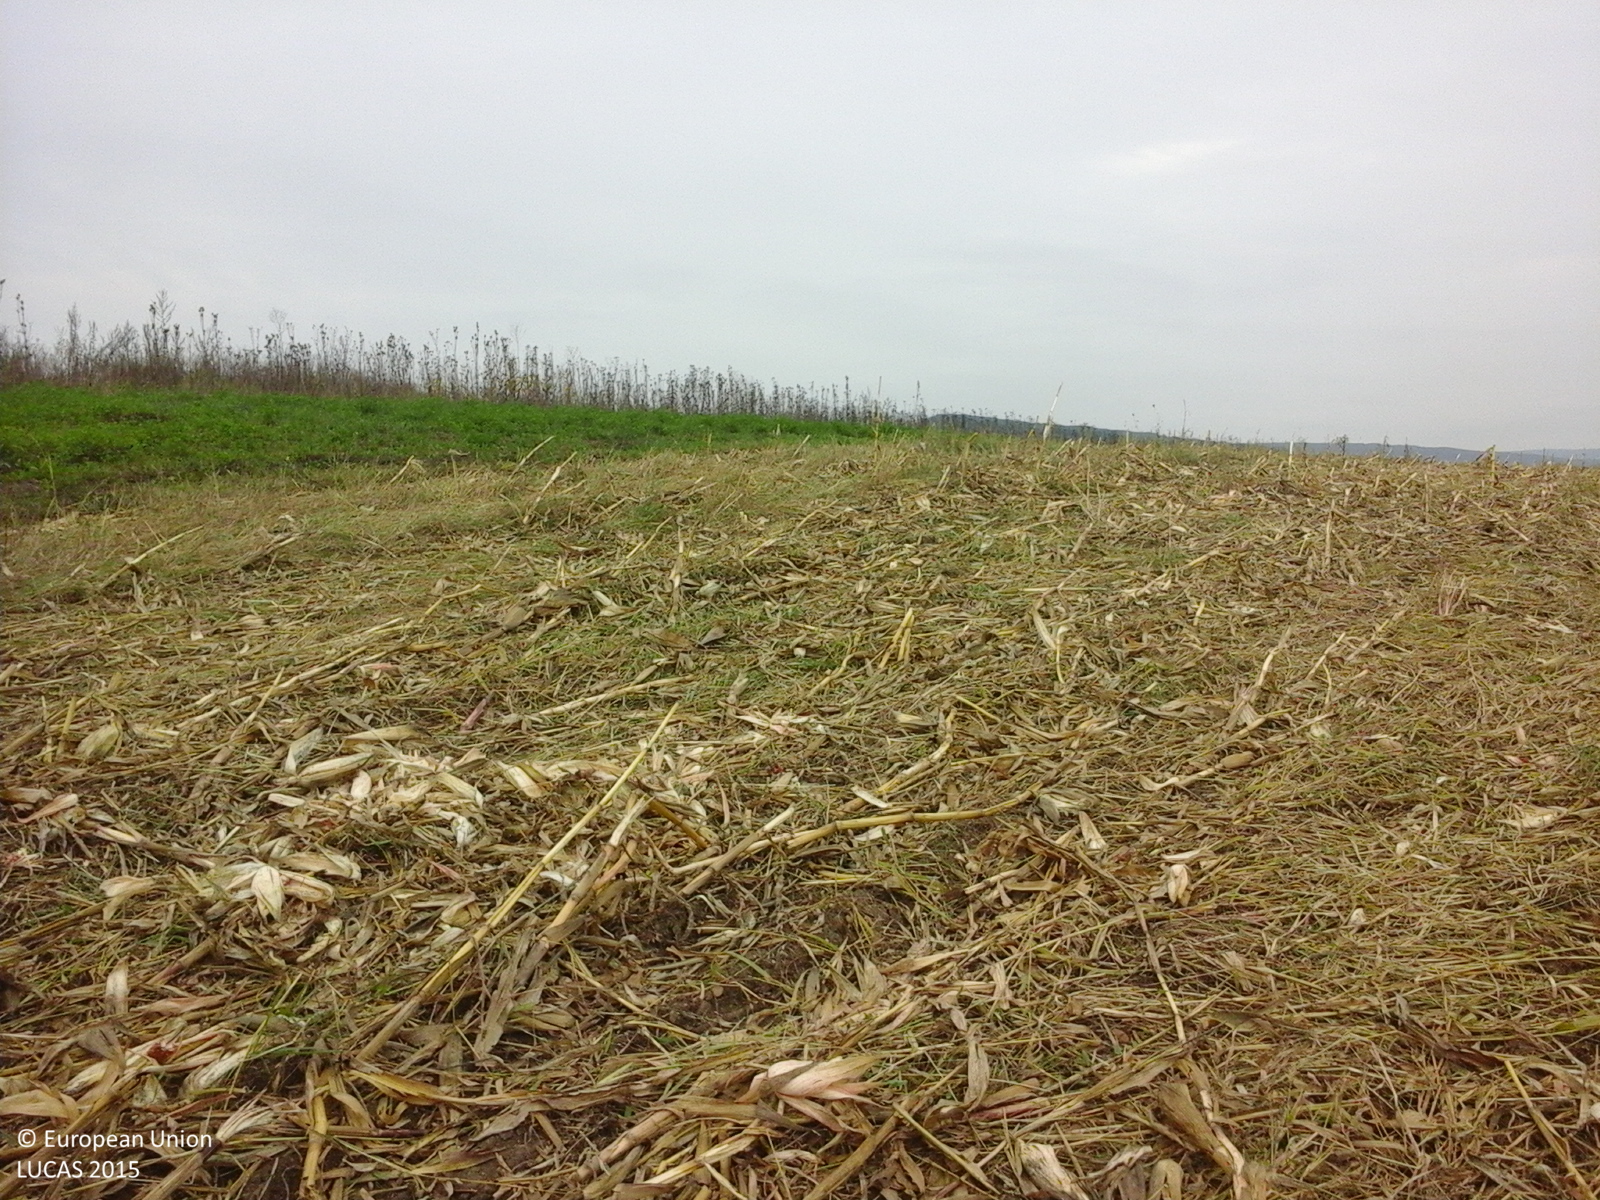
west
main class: Cropland
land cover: Maize
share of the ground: 25 - 50 %
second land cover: Spontaneously vegetated surfaces
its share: 25 - 50 %
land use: Agriculture (excluding fallow land and kitchen gardens)
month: October
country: RO
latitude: 46.0364
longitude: 25.2559
